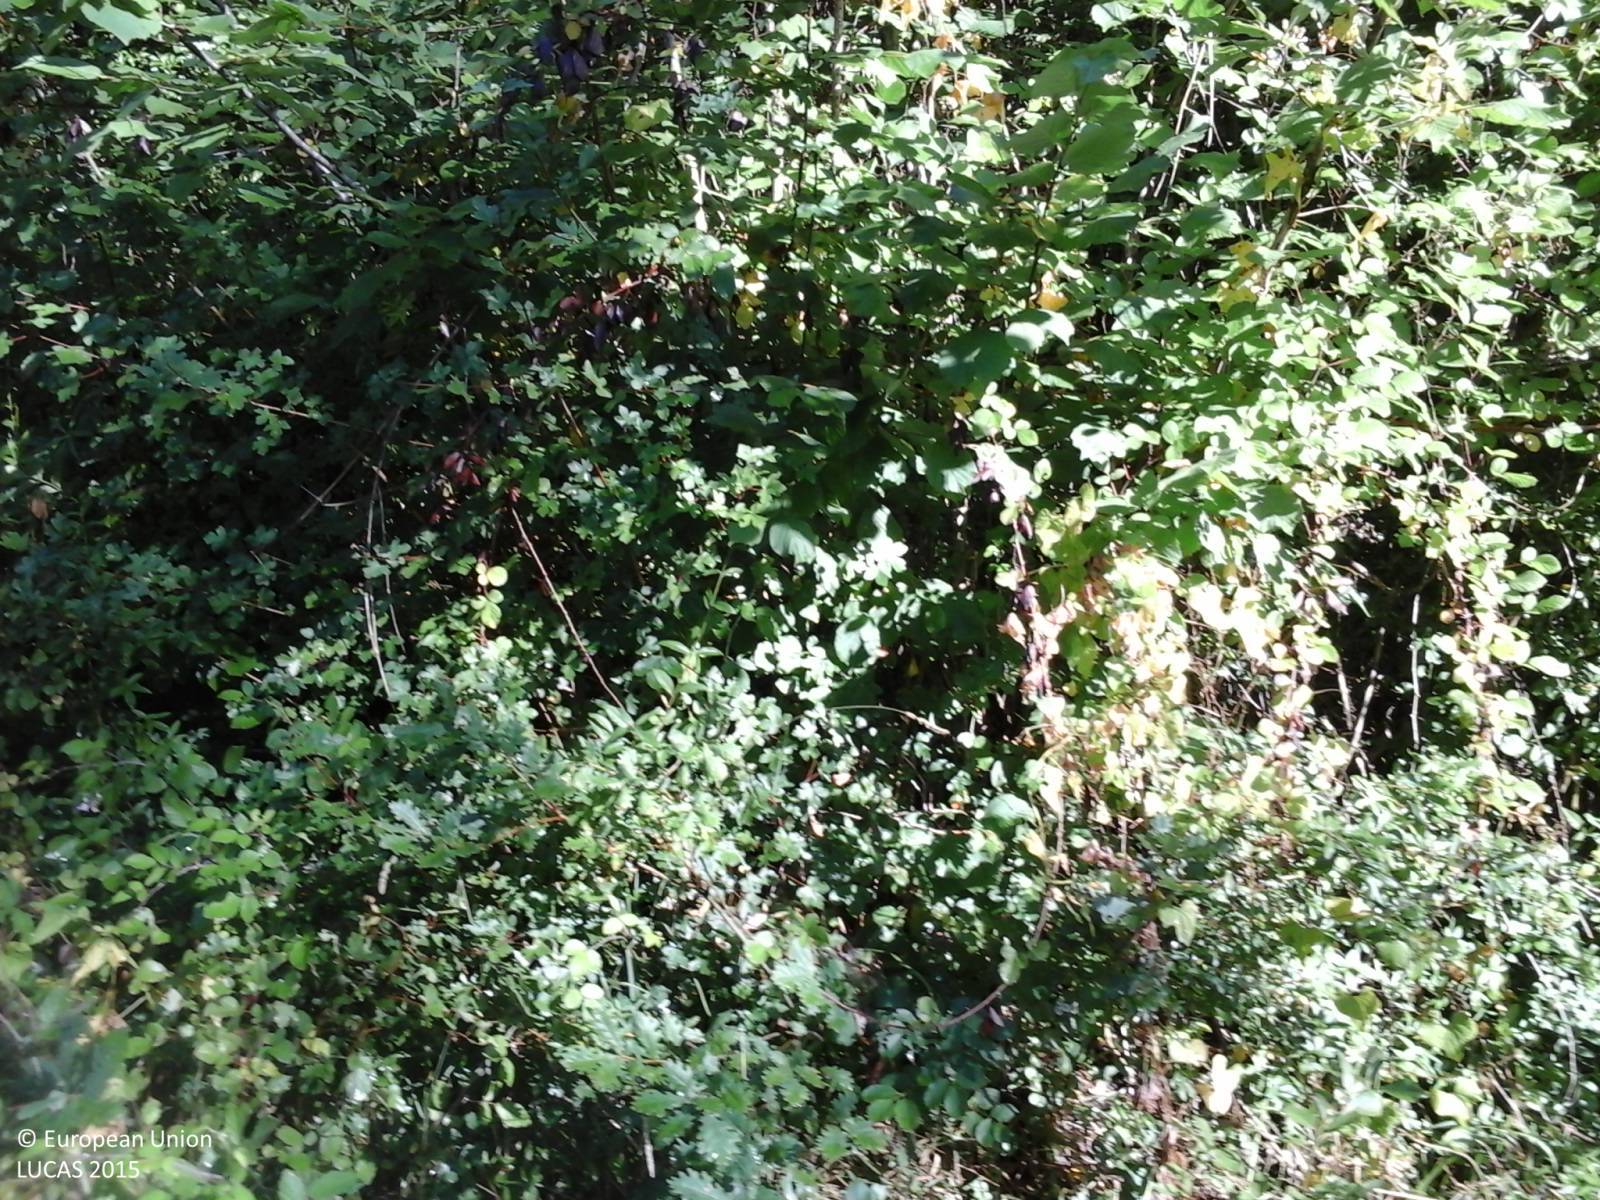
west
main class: Woodland
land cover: Broadleaved woodland
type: thermophilous deciduous forest
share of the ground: > 75 %
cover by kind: broadleaved forest trees 100 %
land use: Forestry
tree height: > 5 m
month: June
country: IT
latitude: 44.2603
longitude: 9.9125
